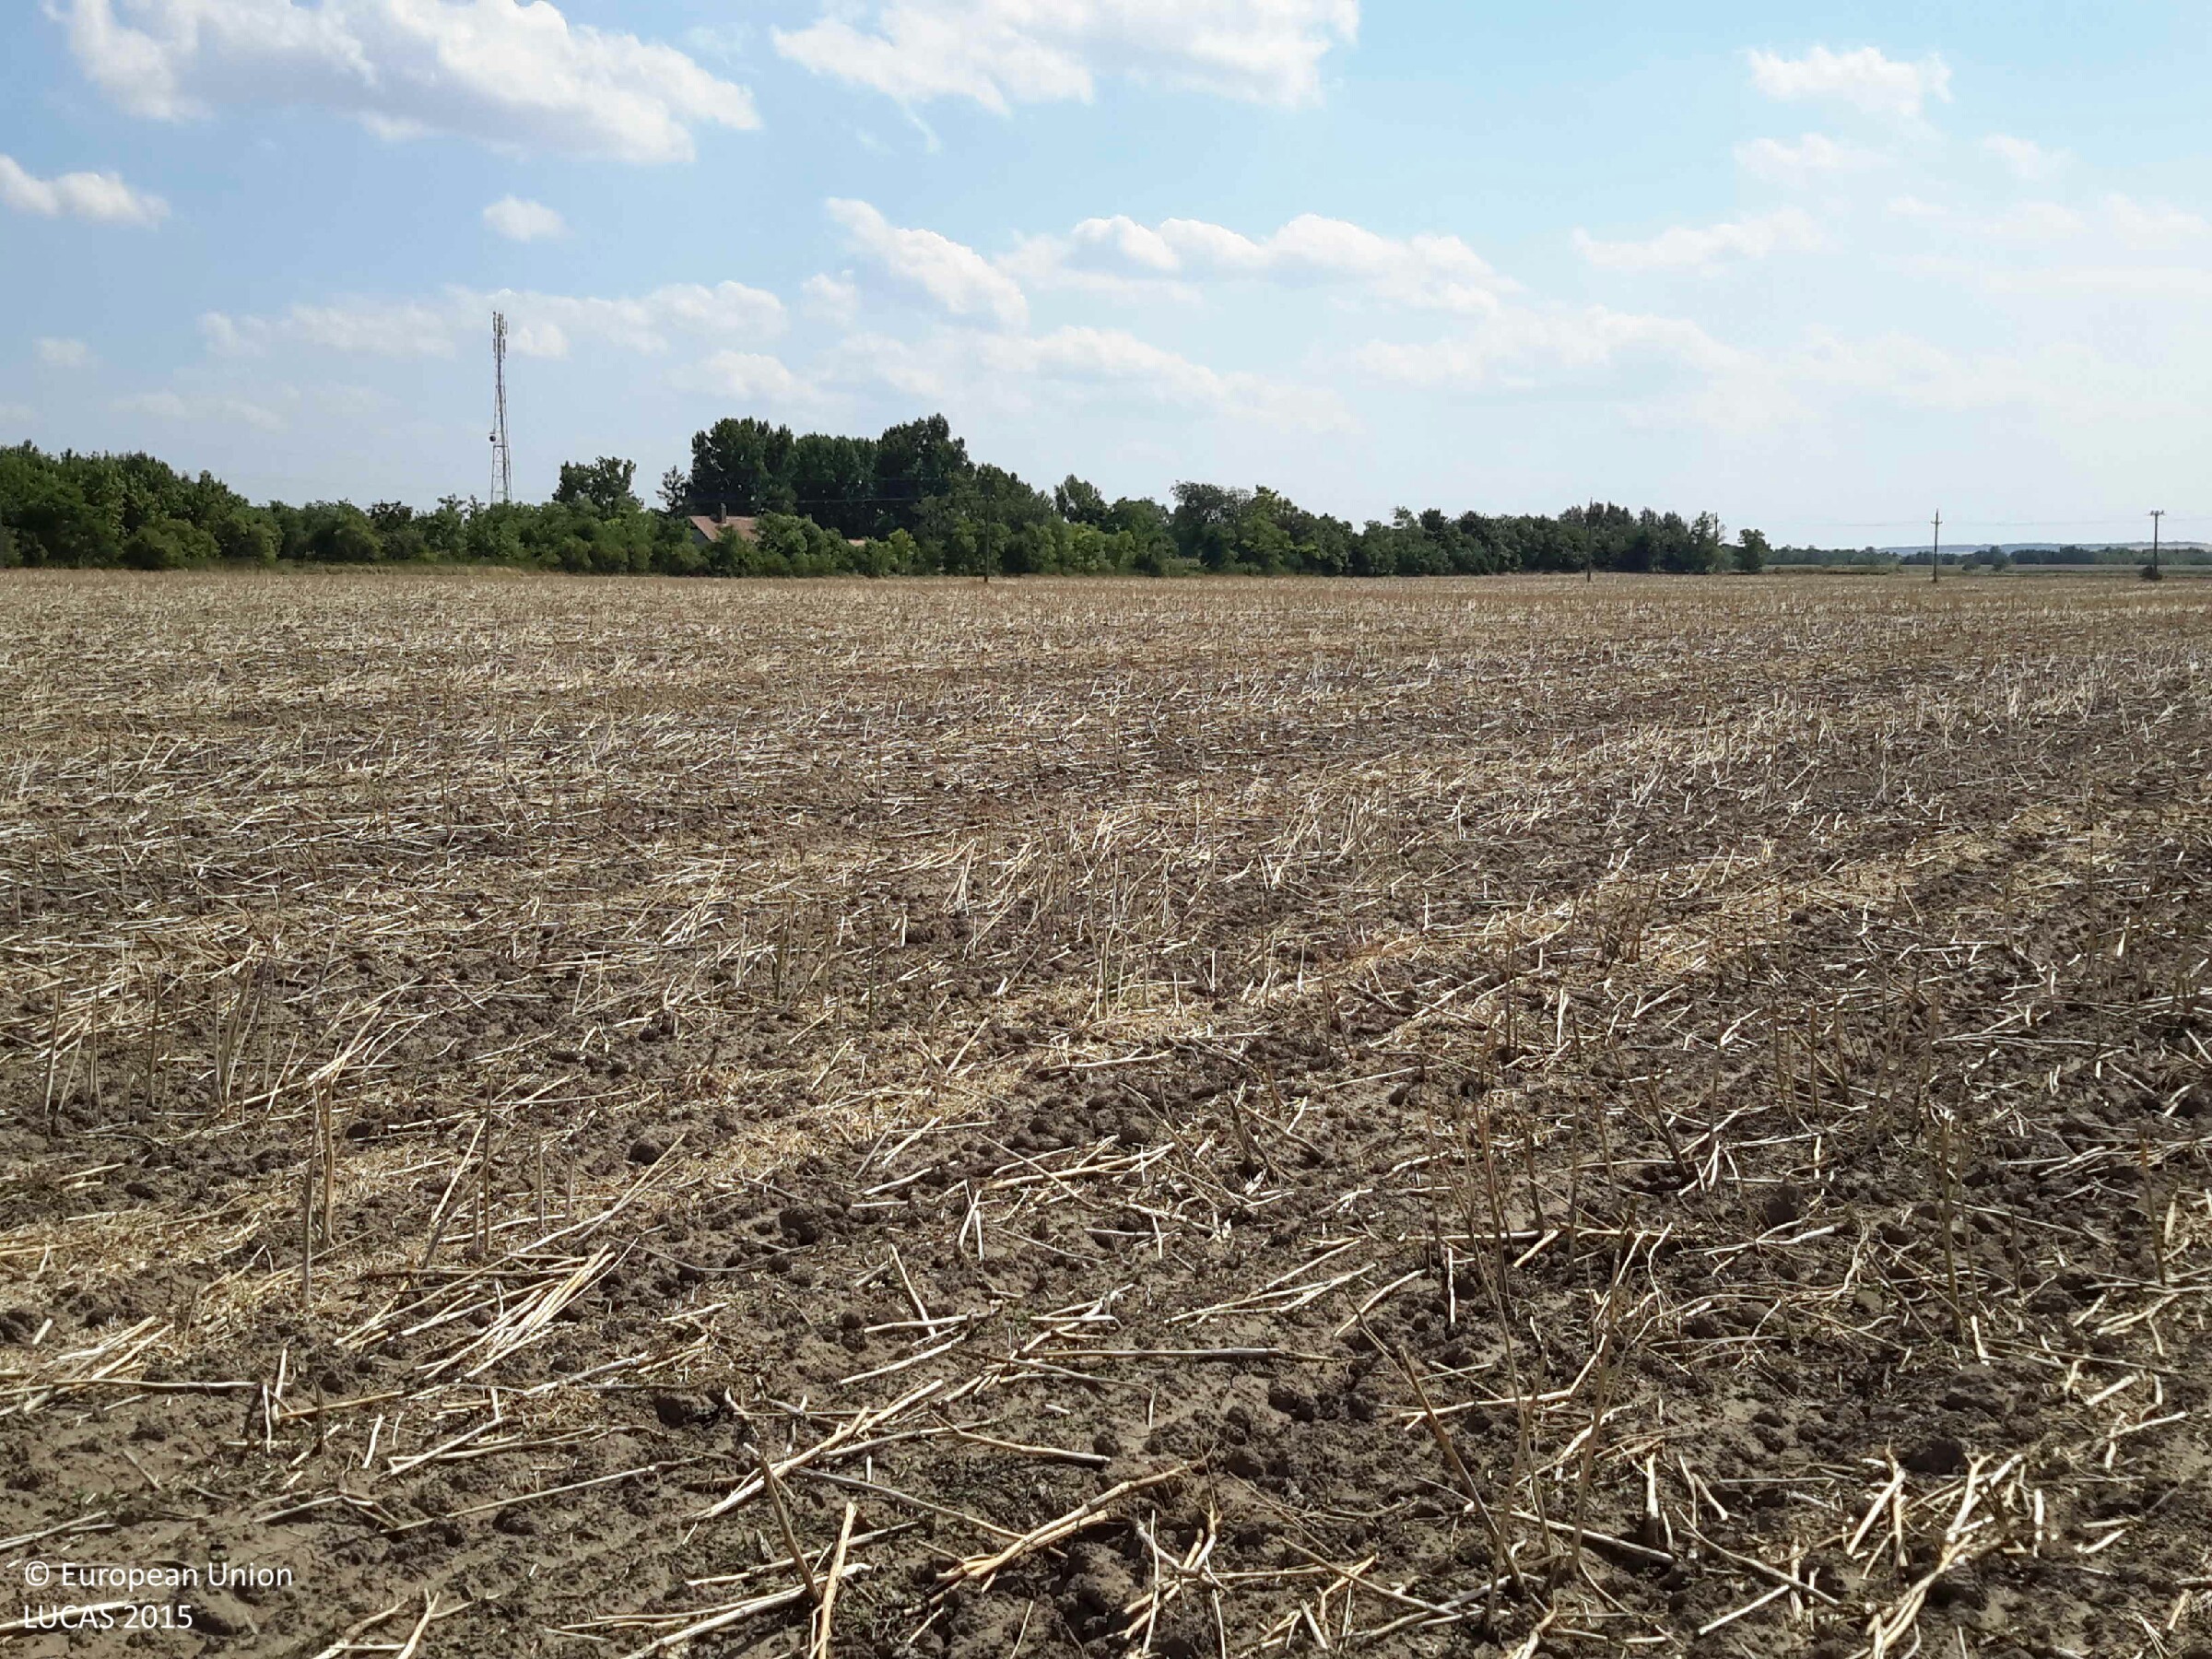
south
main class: Cropland
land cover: Rape and turnip rape
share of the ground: 50 - 75 %
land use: Agriculture (excluding fallow land and kitchen gardens)
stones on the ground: < 10 %
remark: Harvested field
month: July
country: HU
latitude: 47.6003
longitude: 17.8441
